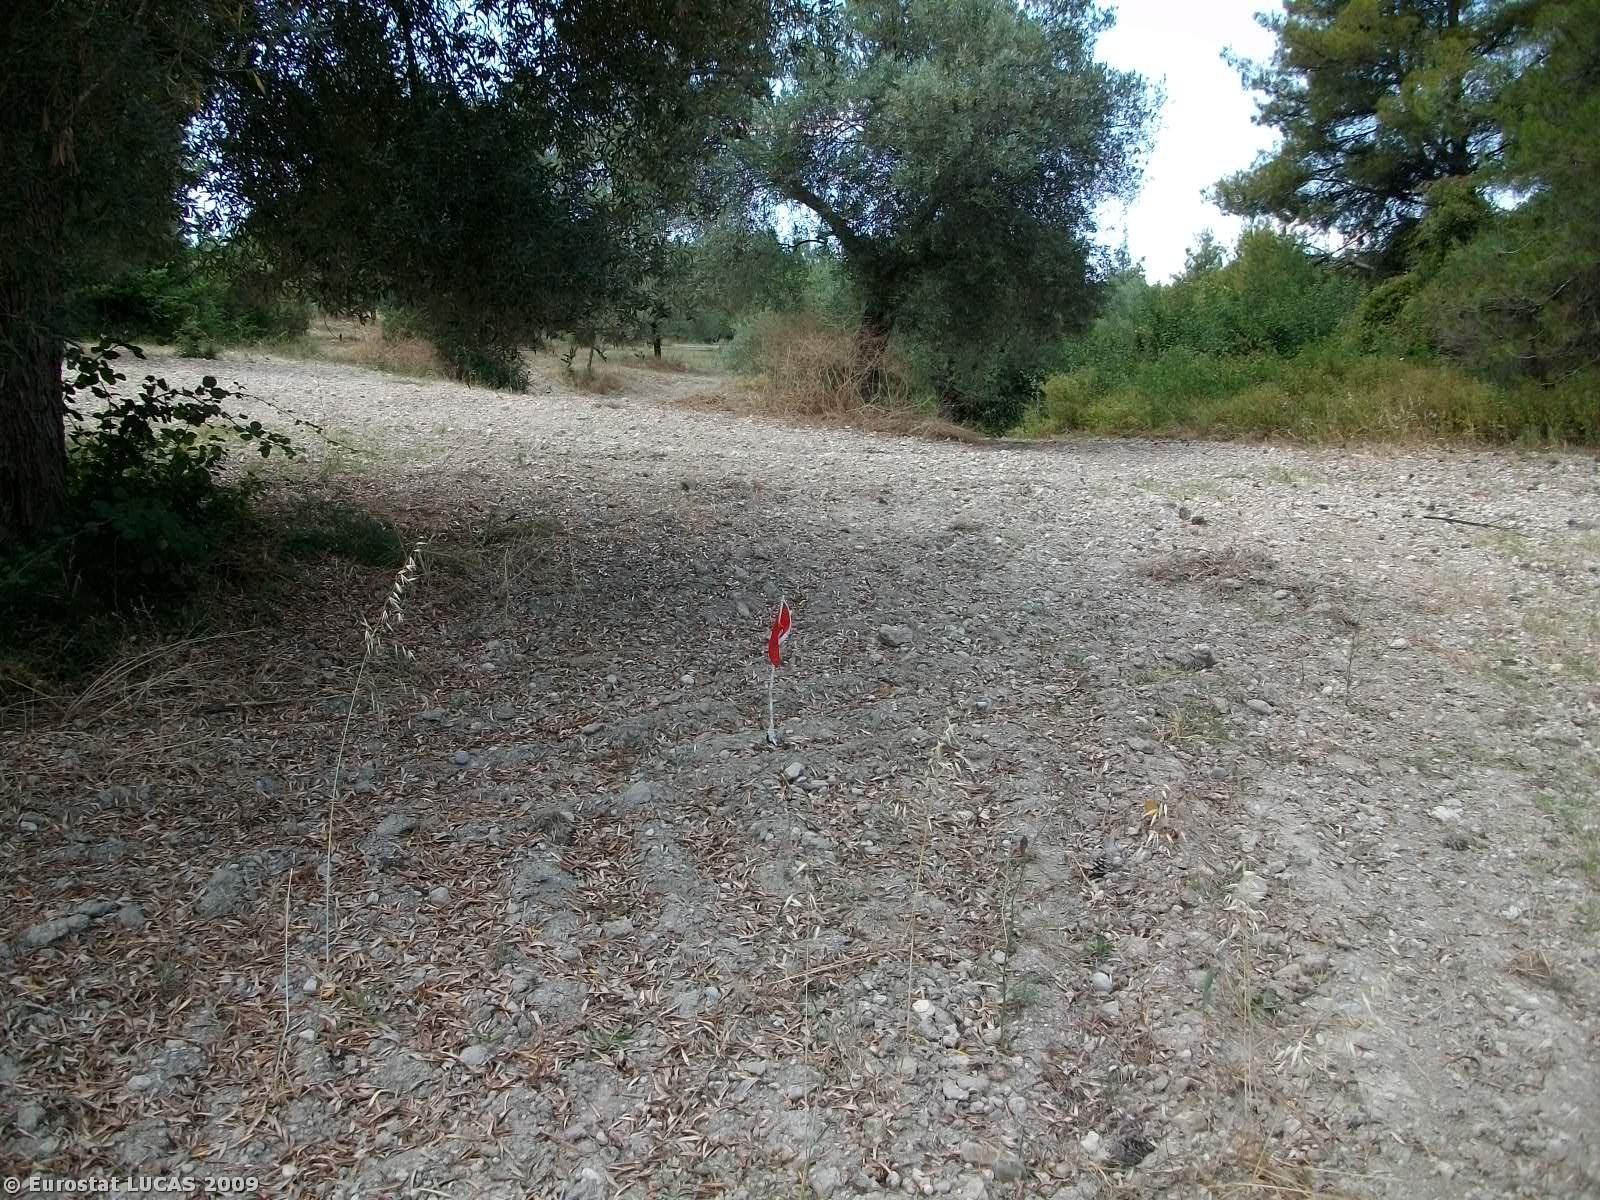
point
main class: Cropland
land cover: Olive groves
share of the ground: 10 - 25 %
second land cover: Bare land
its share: > 75 %
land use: Agriculture (excluding fallow land and kitchen gardens)
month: June
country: GR
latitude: 40.0004
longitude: 23.4168
